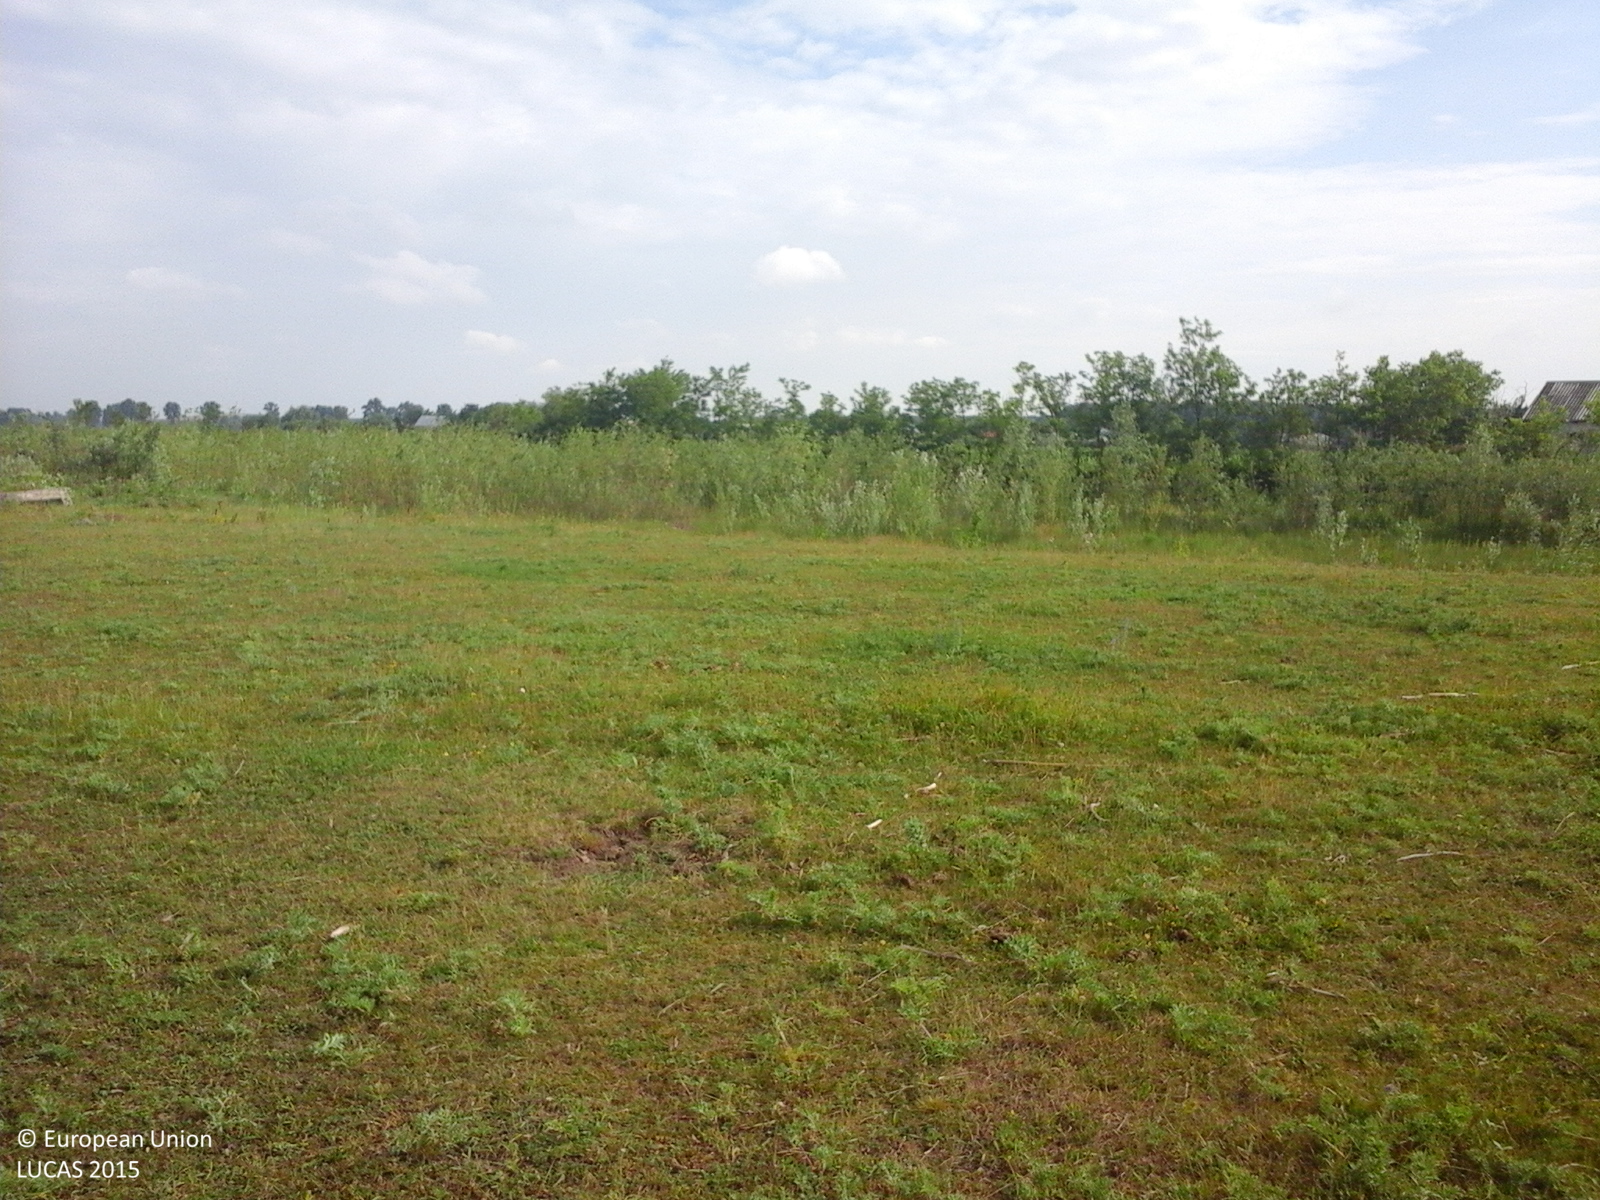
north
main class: Grassland
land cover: Grassland without tree/shrub cover
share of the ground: > 75 %
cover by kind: herbaceous plants 100 %
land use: Agriculture (excluding fallow land and kitchen gardens)
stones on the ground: < 10 %
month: June
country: RO
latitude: 47.0519
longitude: 26.9076
